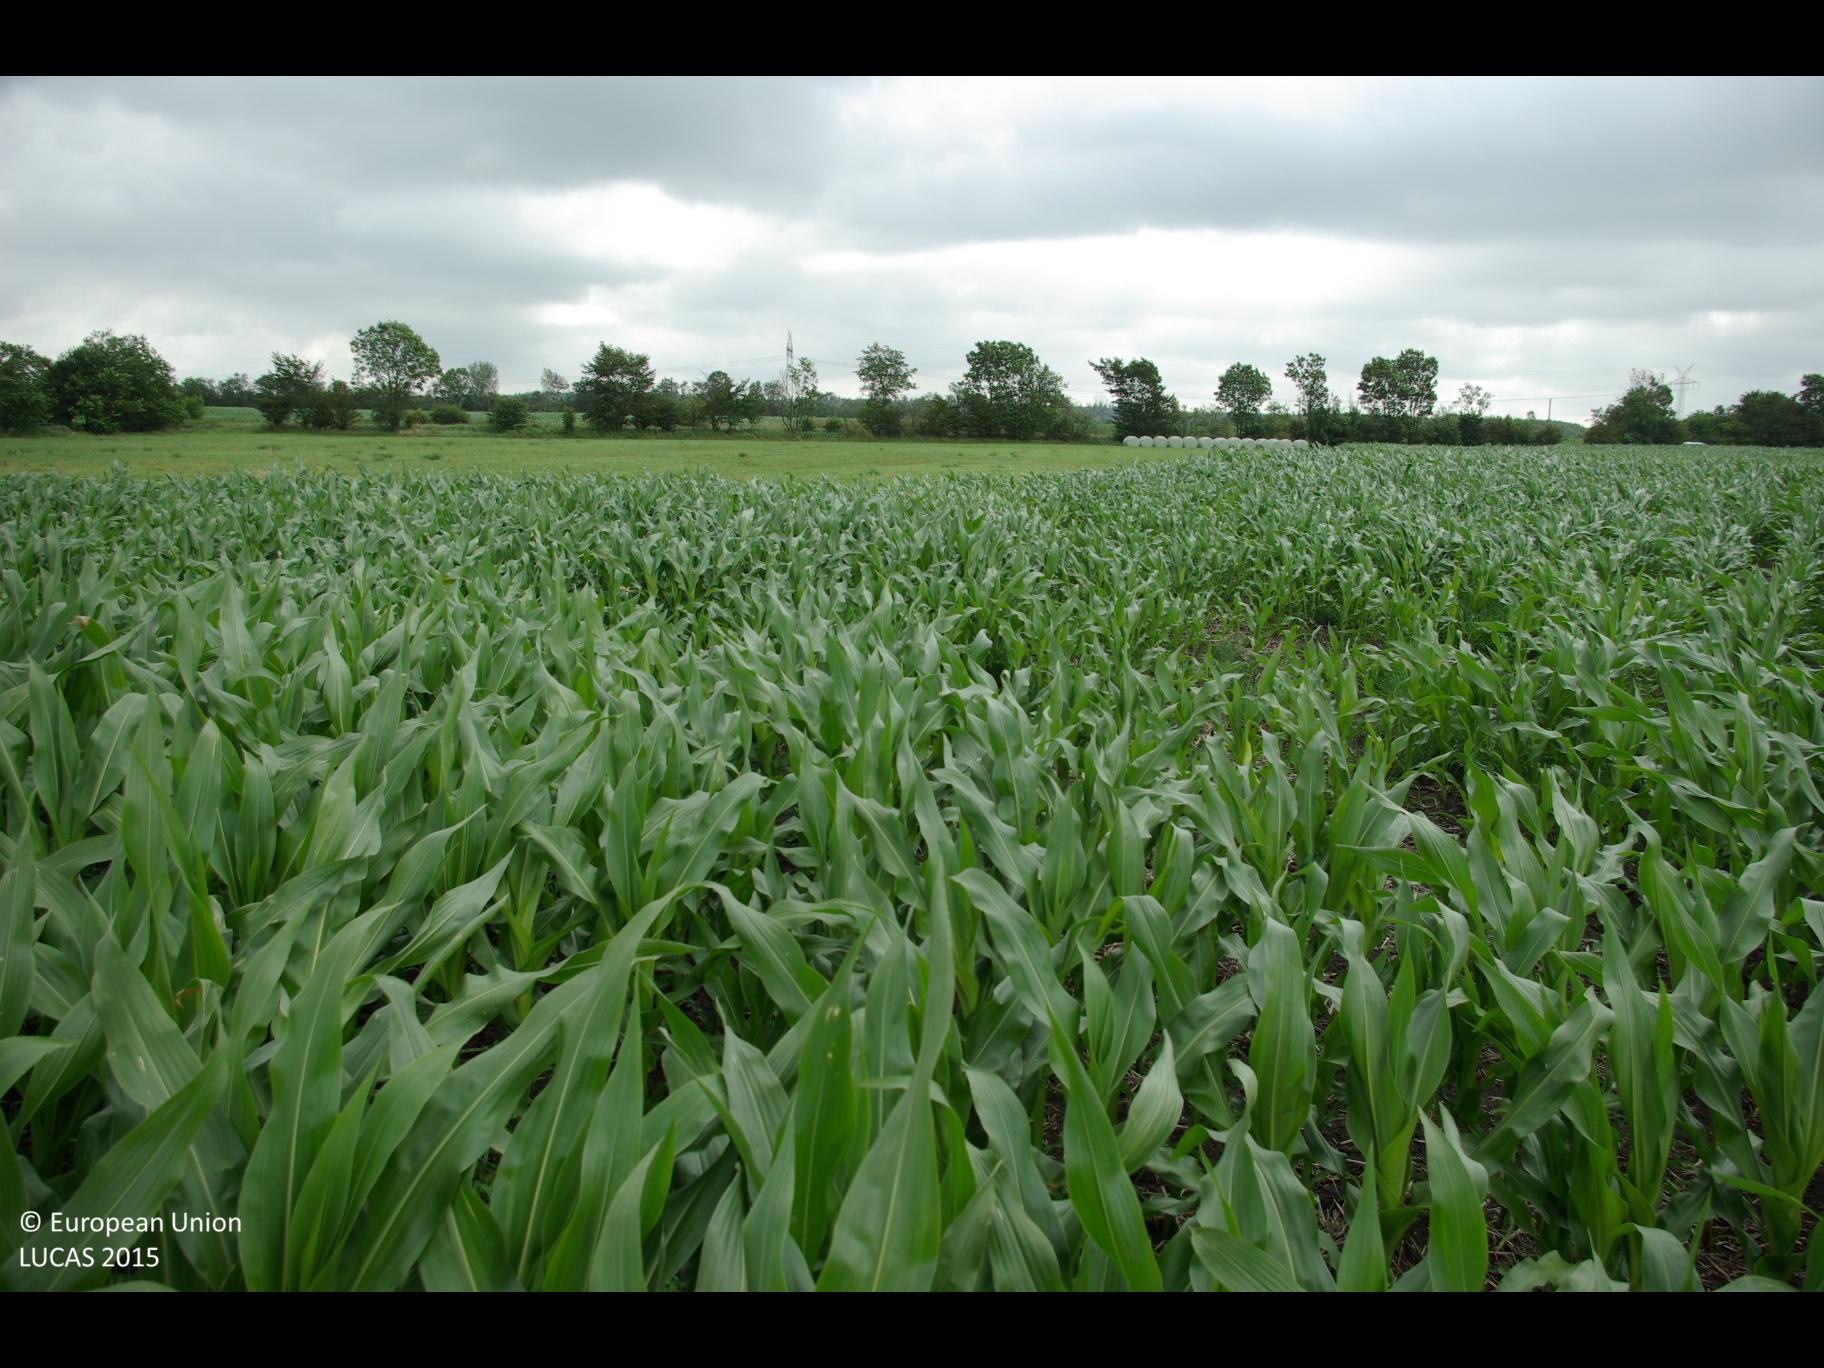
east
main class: Cropland
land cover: Maize
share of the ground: > 75 %
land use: Agriculture (excluding fallow land and kitchen gardens)
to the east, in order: Maize; Grassland without tree/shrub cover; Fences; Managed hedges; Grass margins; Paved roads, cycling and walking lanes; Grass margins; Electric lines; Spontaneously vegetated surfaces; Maize
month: July
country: DE
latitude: 54.7479
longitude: 9.3014
